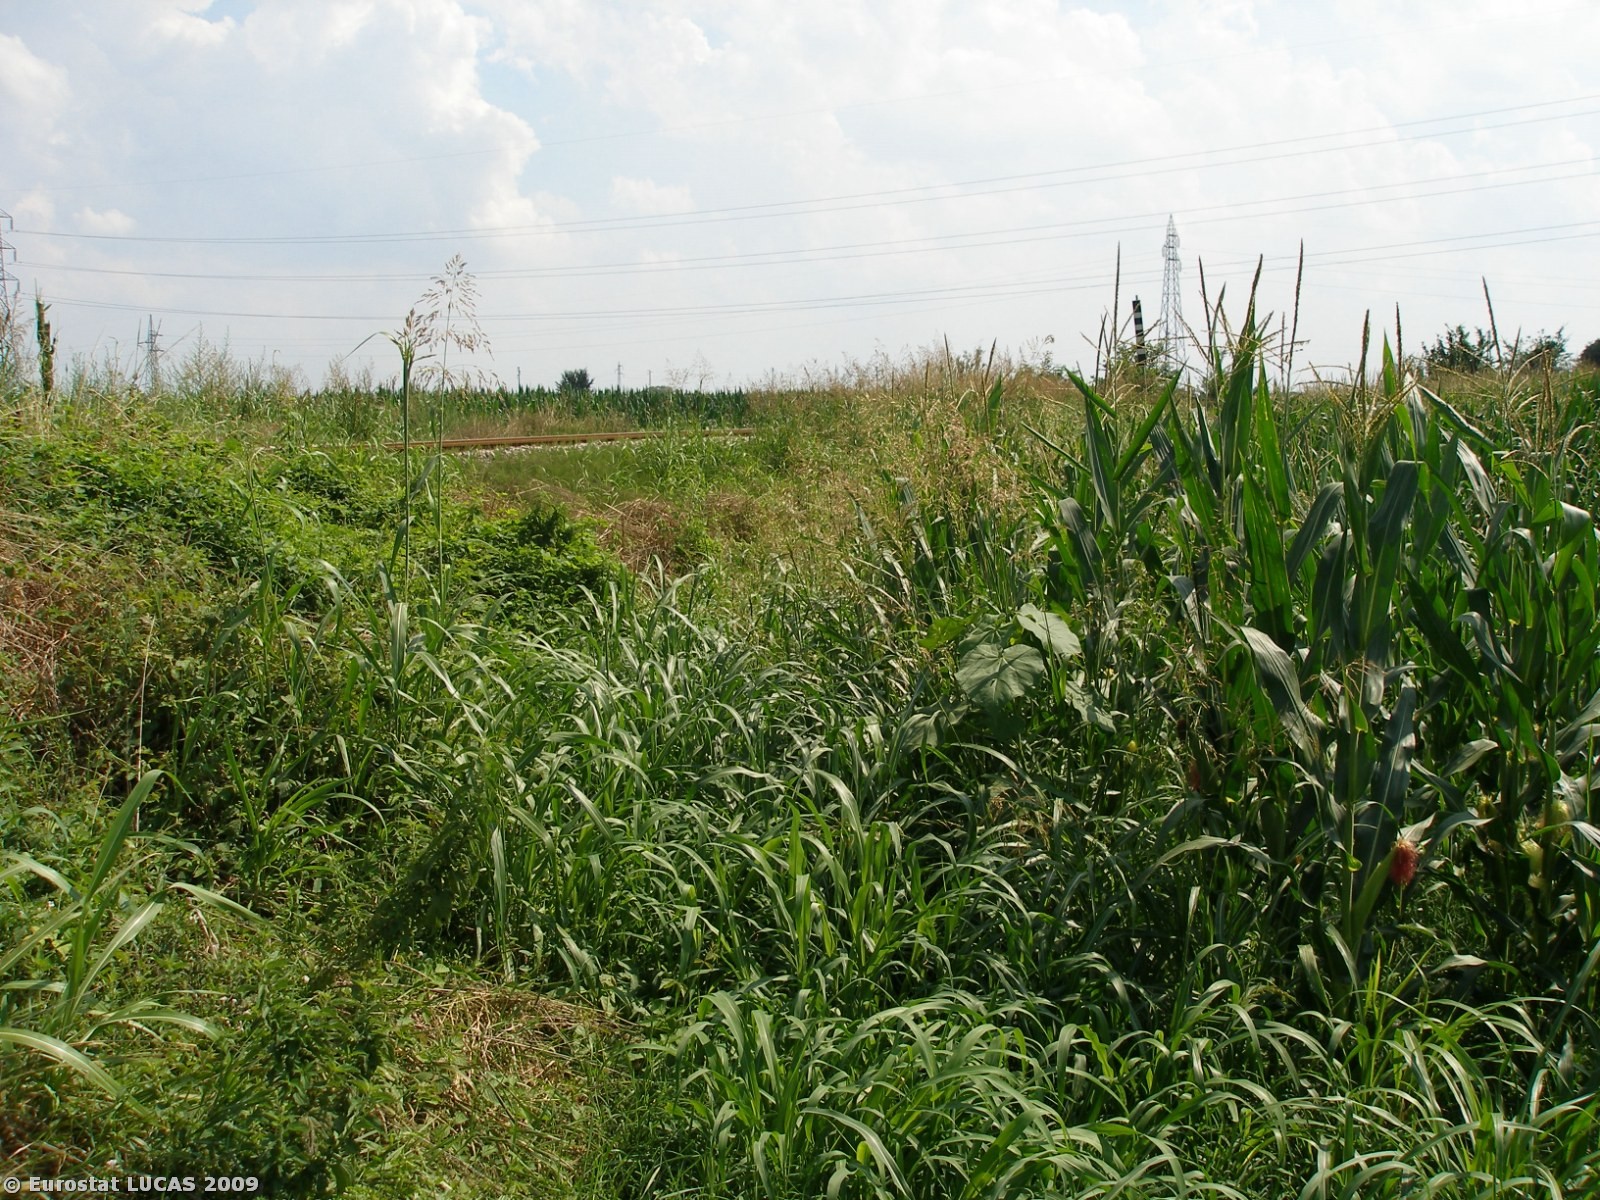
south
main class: Cropland
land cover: Maize
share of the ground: > 75 %
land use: Agriculture (excluding fallow land and kitchen gardens)
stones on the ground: < 10 %
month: July
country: IT
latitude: 45.0695
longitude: 12.0666
